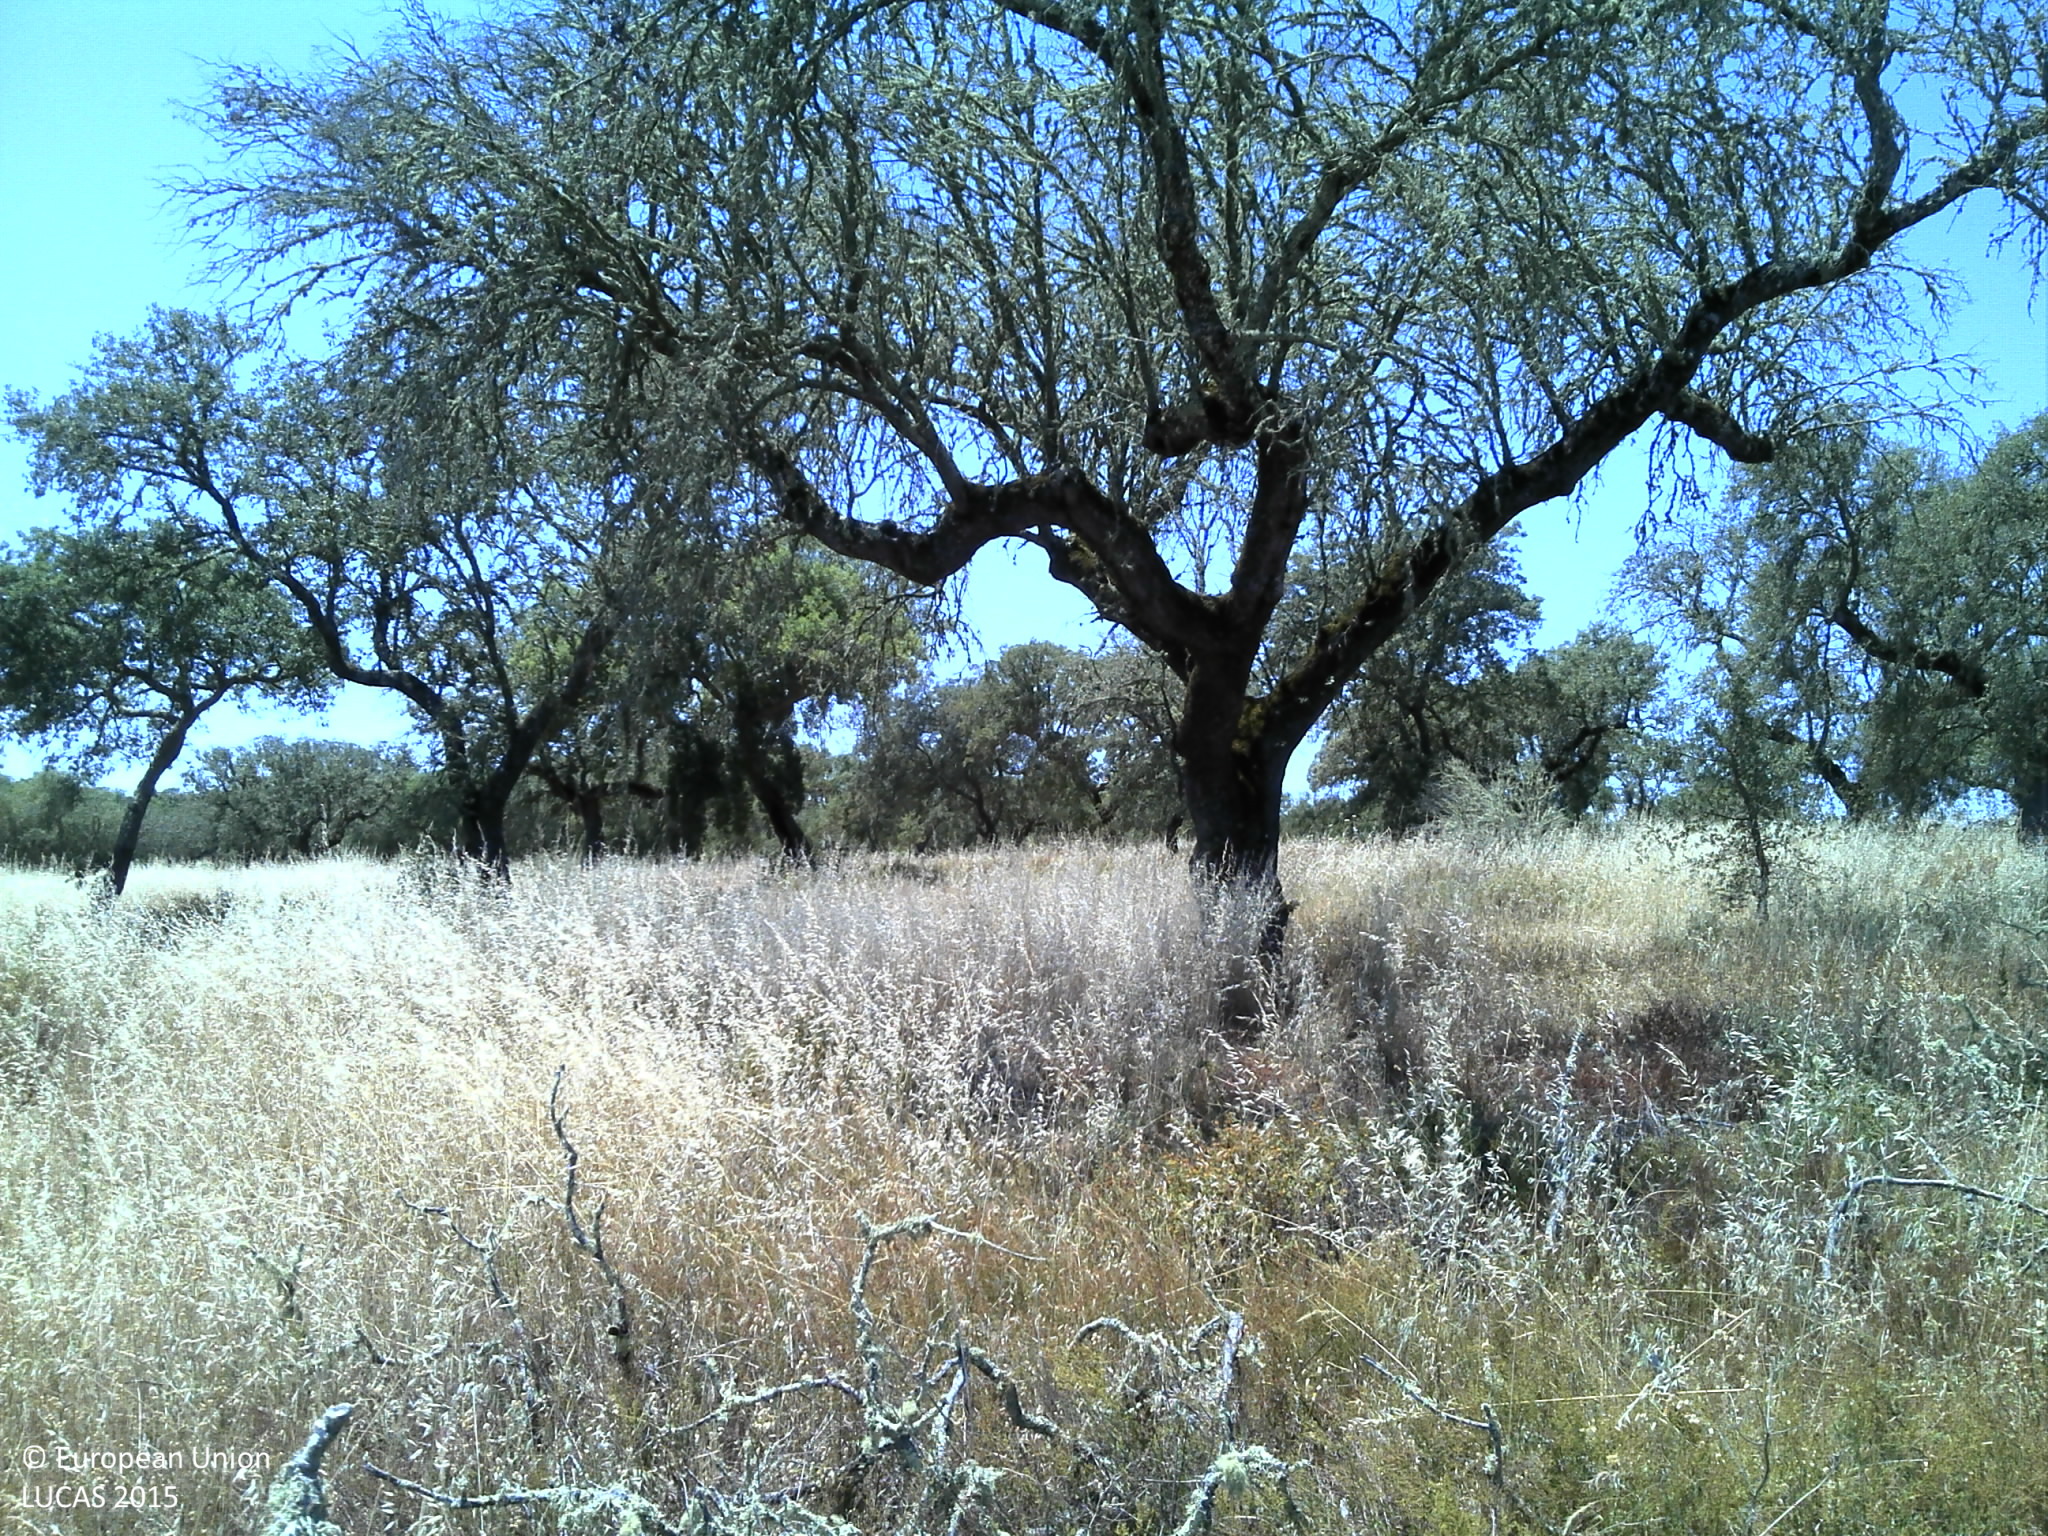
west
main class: Woodland
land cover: Broadleaved woodland
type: broadleaved evergreen forest
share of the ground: 25 - 50 %
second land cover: Grassland without tree/shrub cover
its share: 50 - 75 %
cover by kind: herbaceous plants 75 %, unconsolidated bare surface 15 %, broadleaved forest trees 10 %
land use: Forestry
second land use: Agriculture (excluding fallow land and kitchen gardens)
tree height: > 5 m
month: June
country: PT
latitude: 38.8202
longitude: -7.7428
